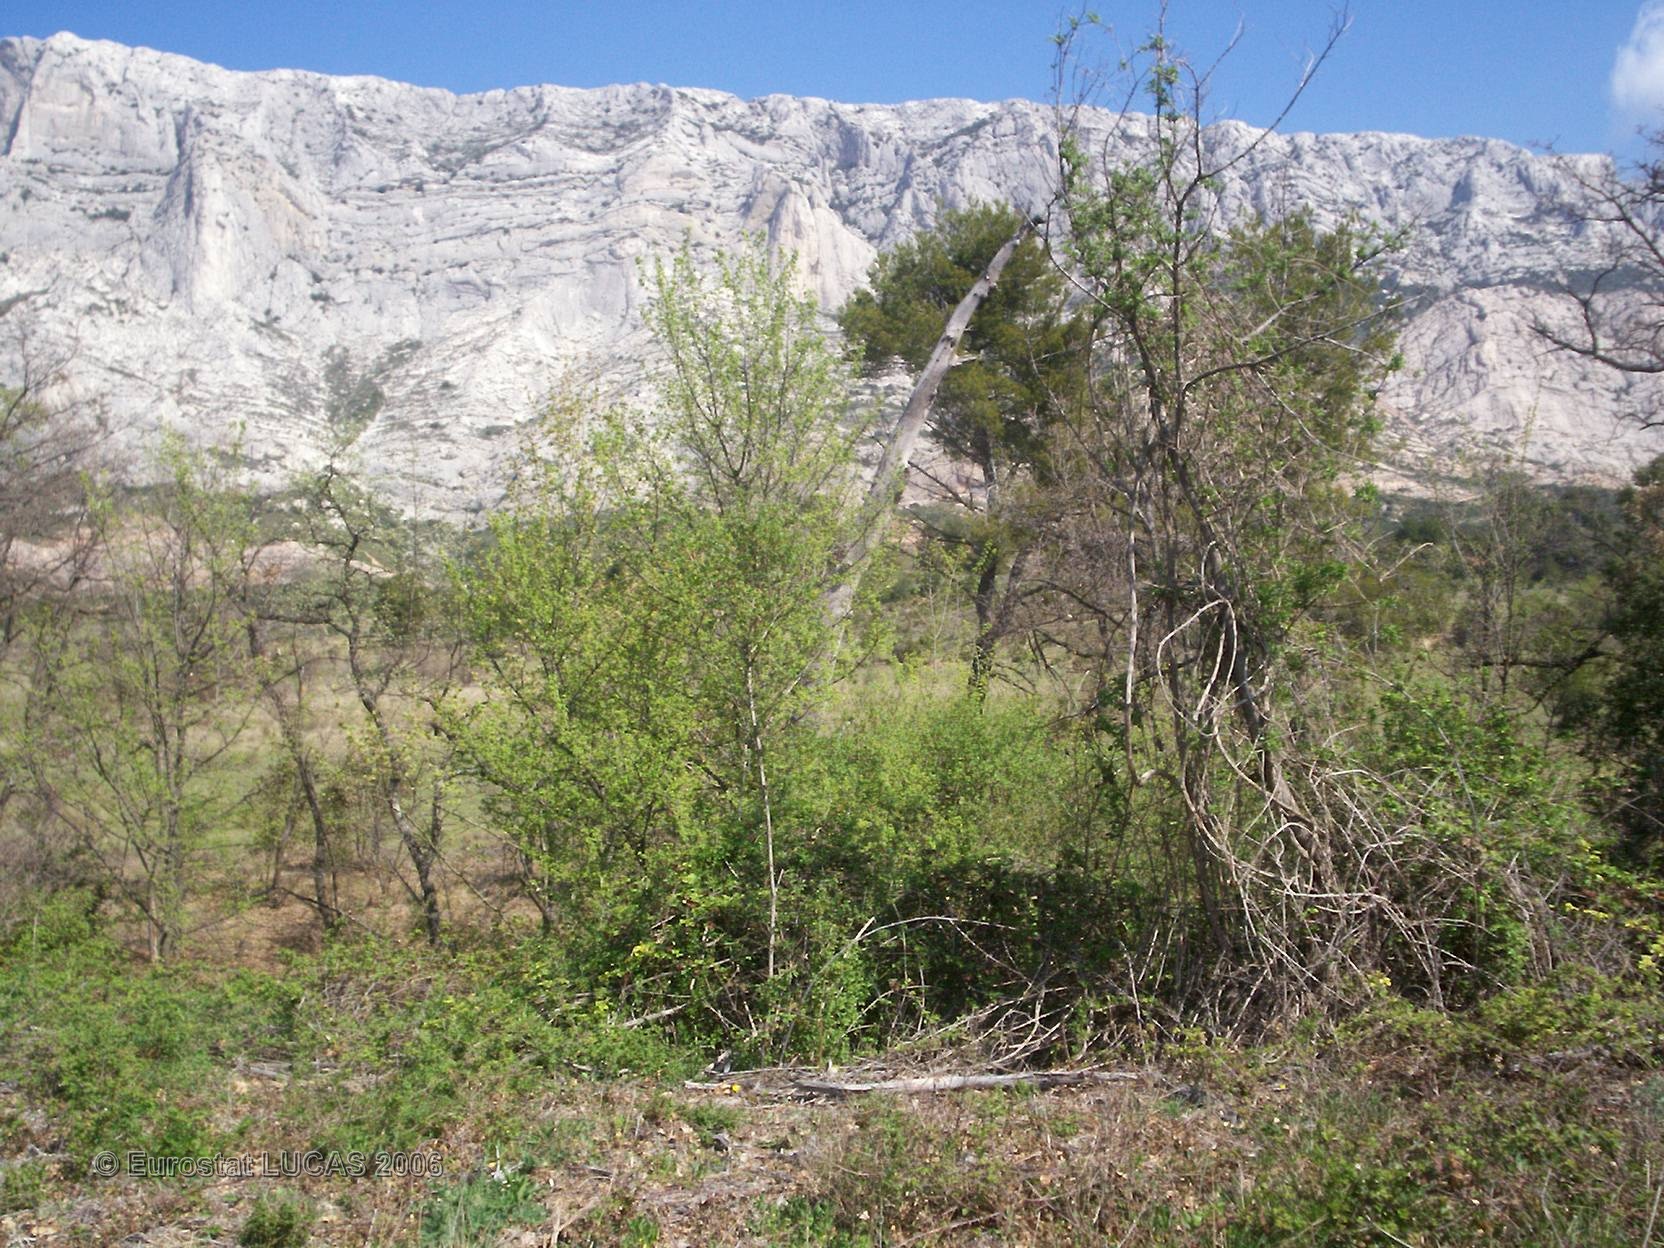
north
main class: Cropland
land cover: Nuts trees
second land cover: Grassland with sparse tree/shrub cover
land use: Agriculture (excluding fallow land and kitchen gardens)
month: April
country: FR
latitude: 43.5163
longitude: 5.5932
